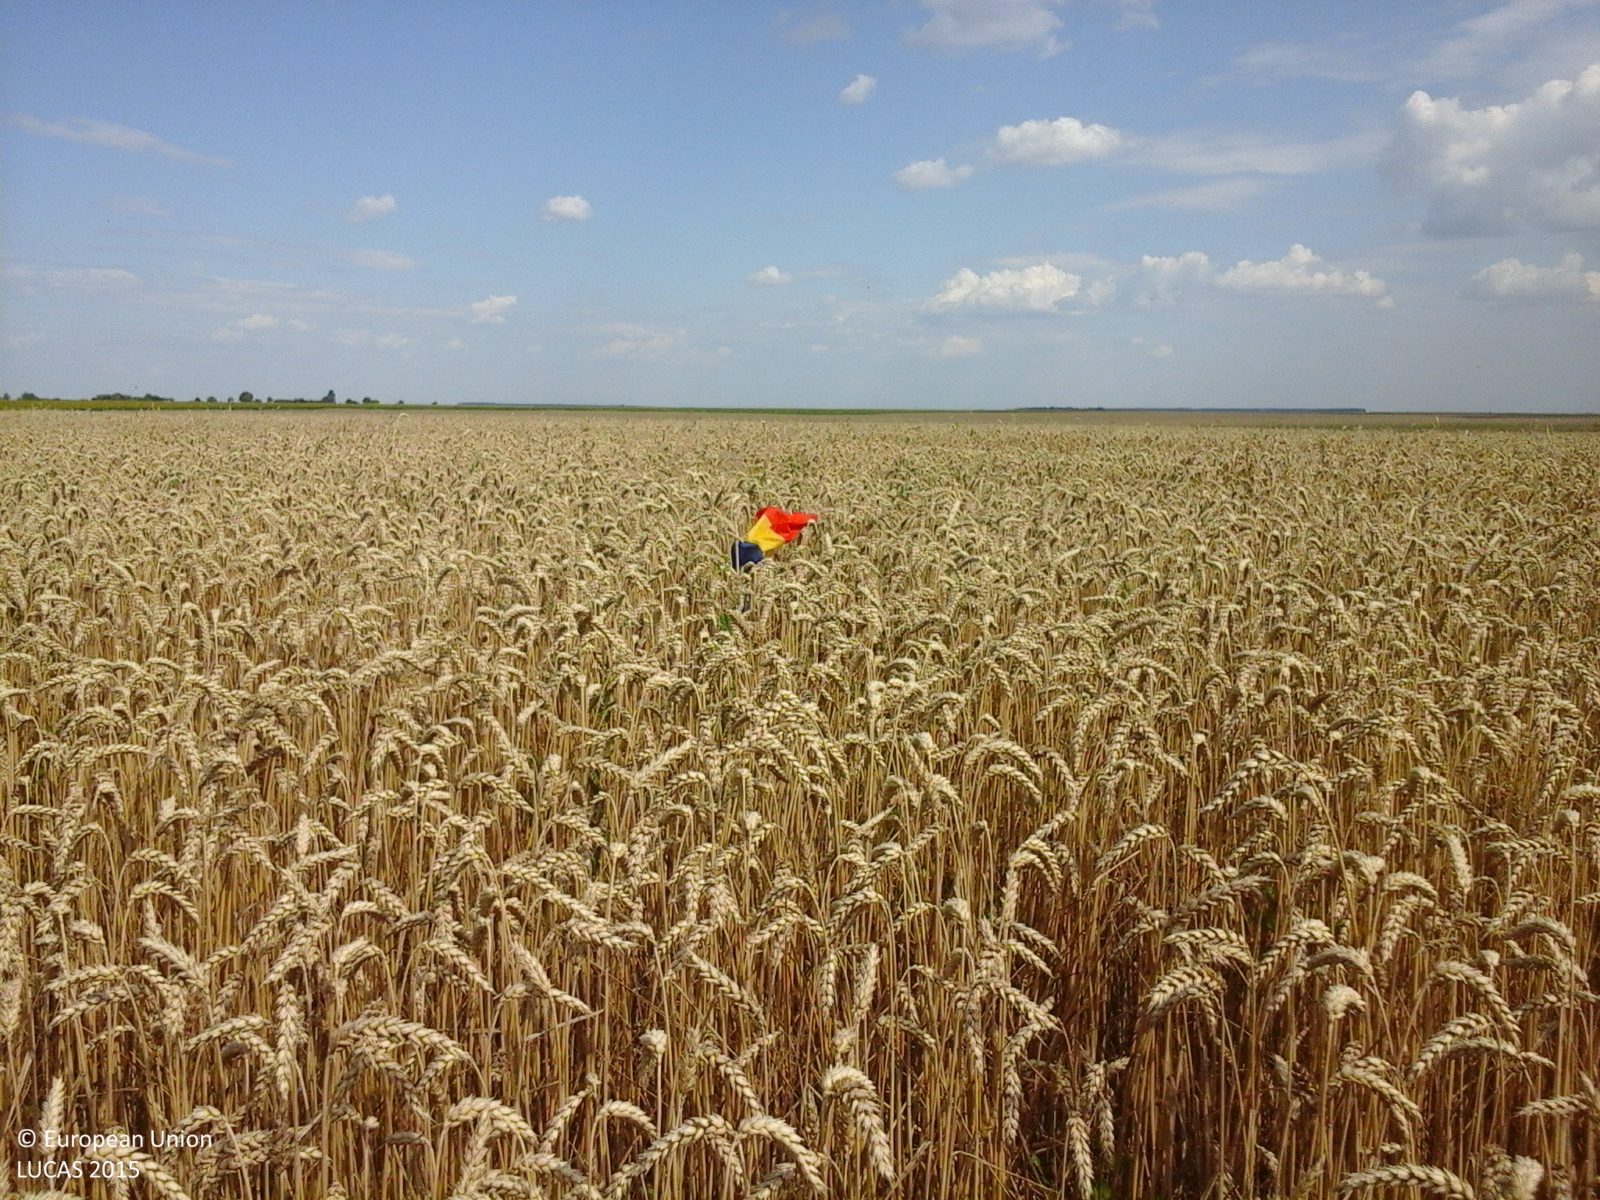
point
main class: Cropland
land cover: Common wheat
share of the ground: > 75 %
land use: Agriculture (excluding fallow land and kitchen gardens)
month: July
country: RO
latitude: 44.0708
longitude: 24.6661
